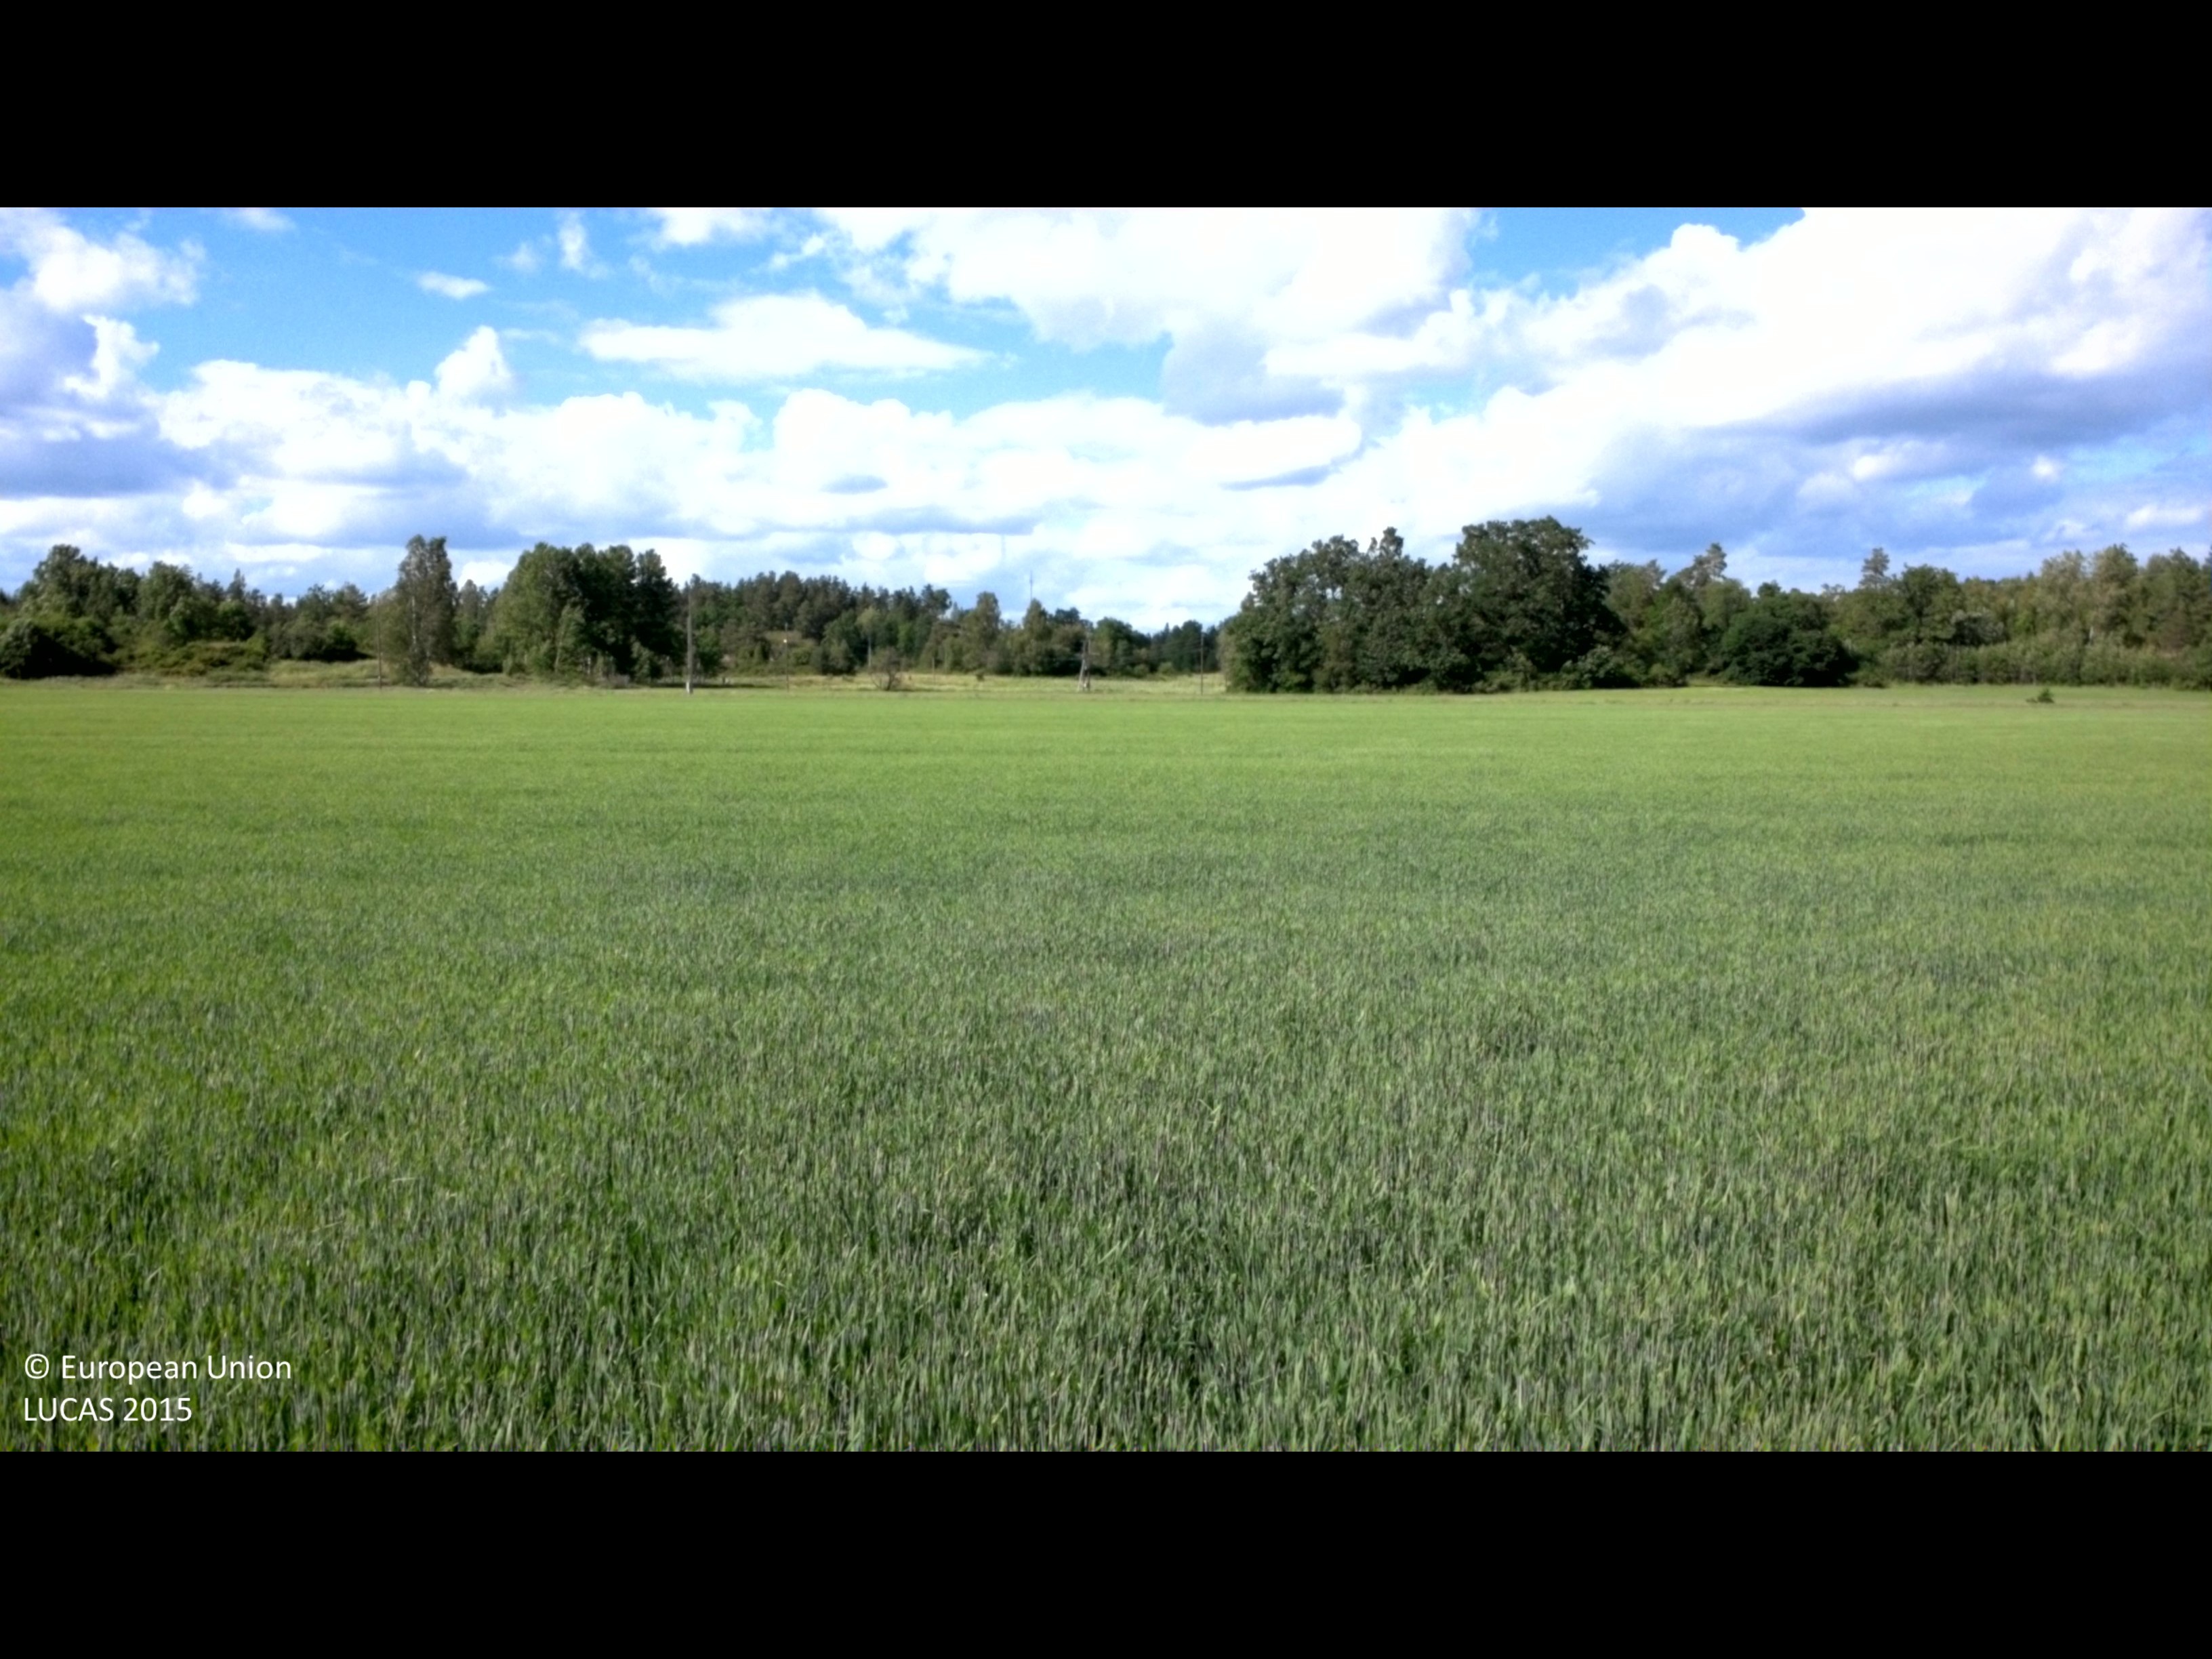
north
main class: Cropland
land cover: Barley
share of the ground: > 75 %
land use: Agriculture (excluding fallow land and kitchen gardens)
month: June
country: SE
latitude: 58.0903
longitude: 16.6640
